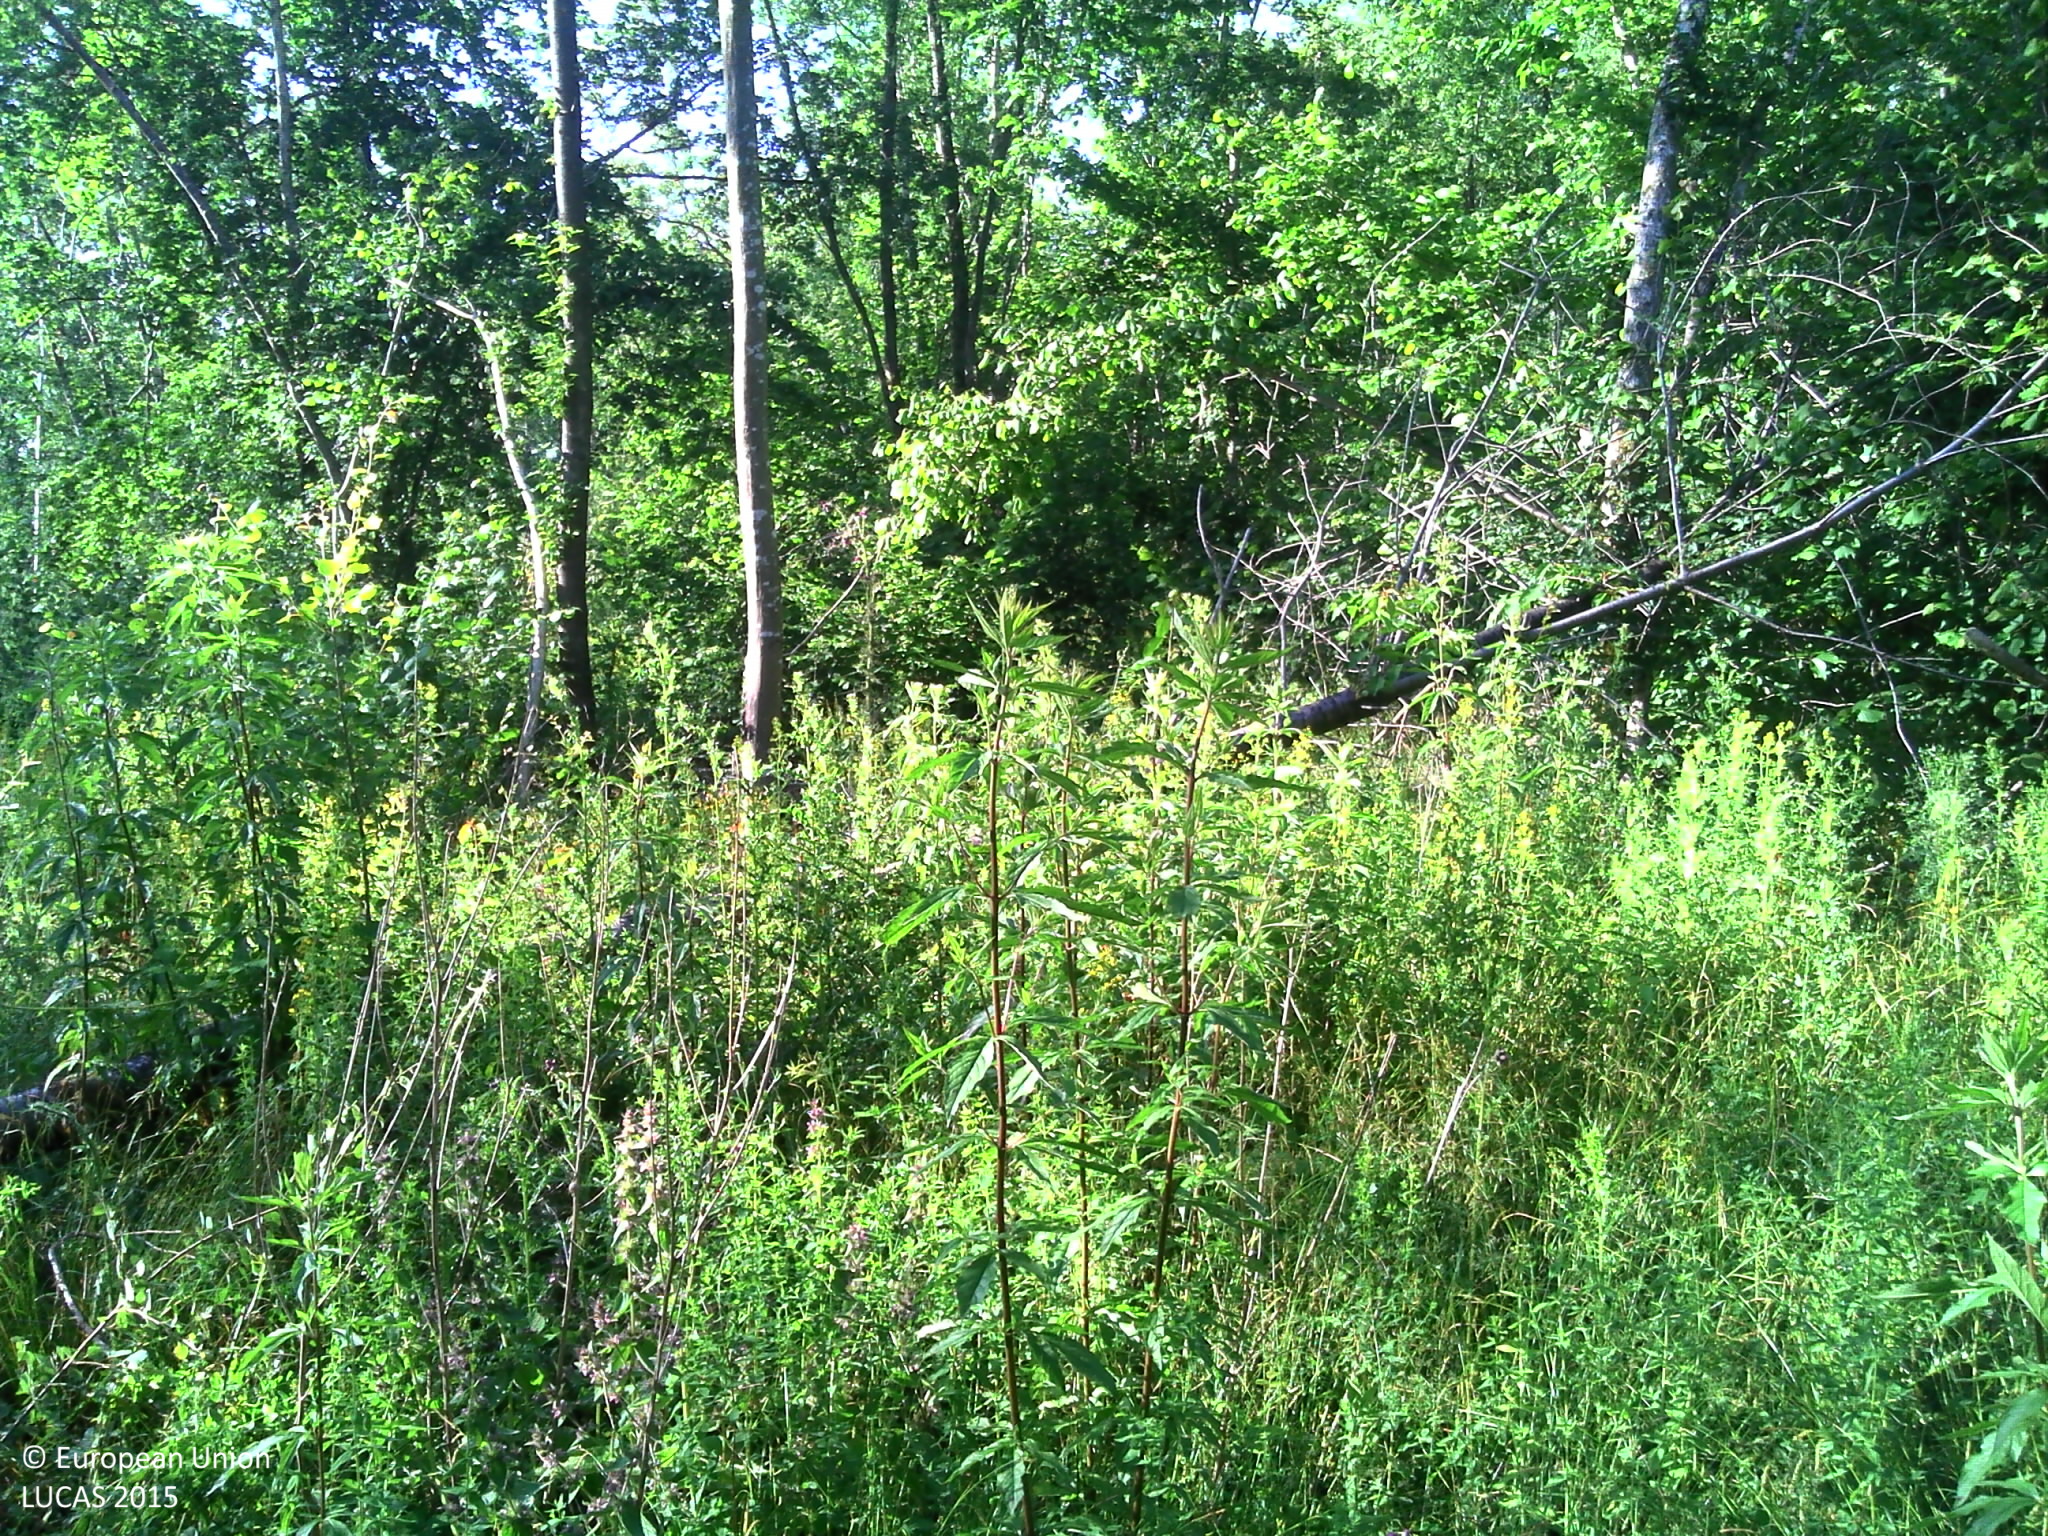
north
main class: Woodland
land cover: Broadleaved woodland
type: acidophilous oak and oak-birch forest
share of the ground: > 75 %
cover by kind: broadleaved forest trees 95 %, lichens and mosses 5 %
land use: Forestry
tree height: > 5 m
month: June
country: FR
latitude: 48.5452
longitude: 0.1785
